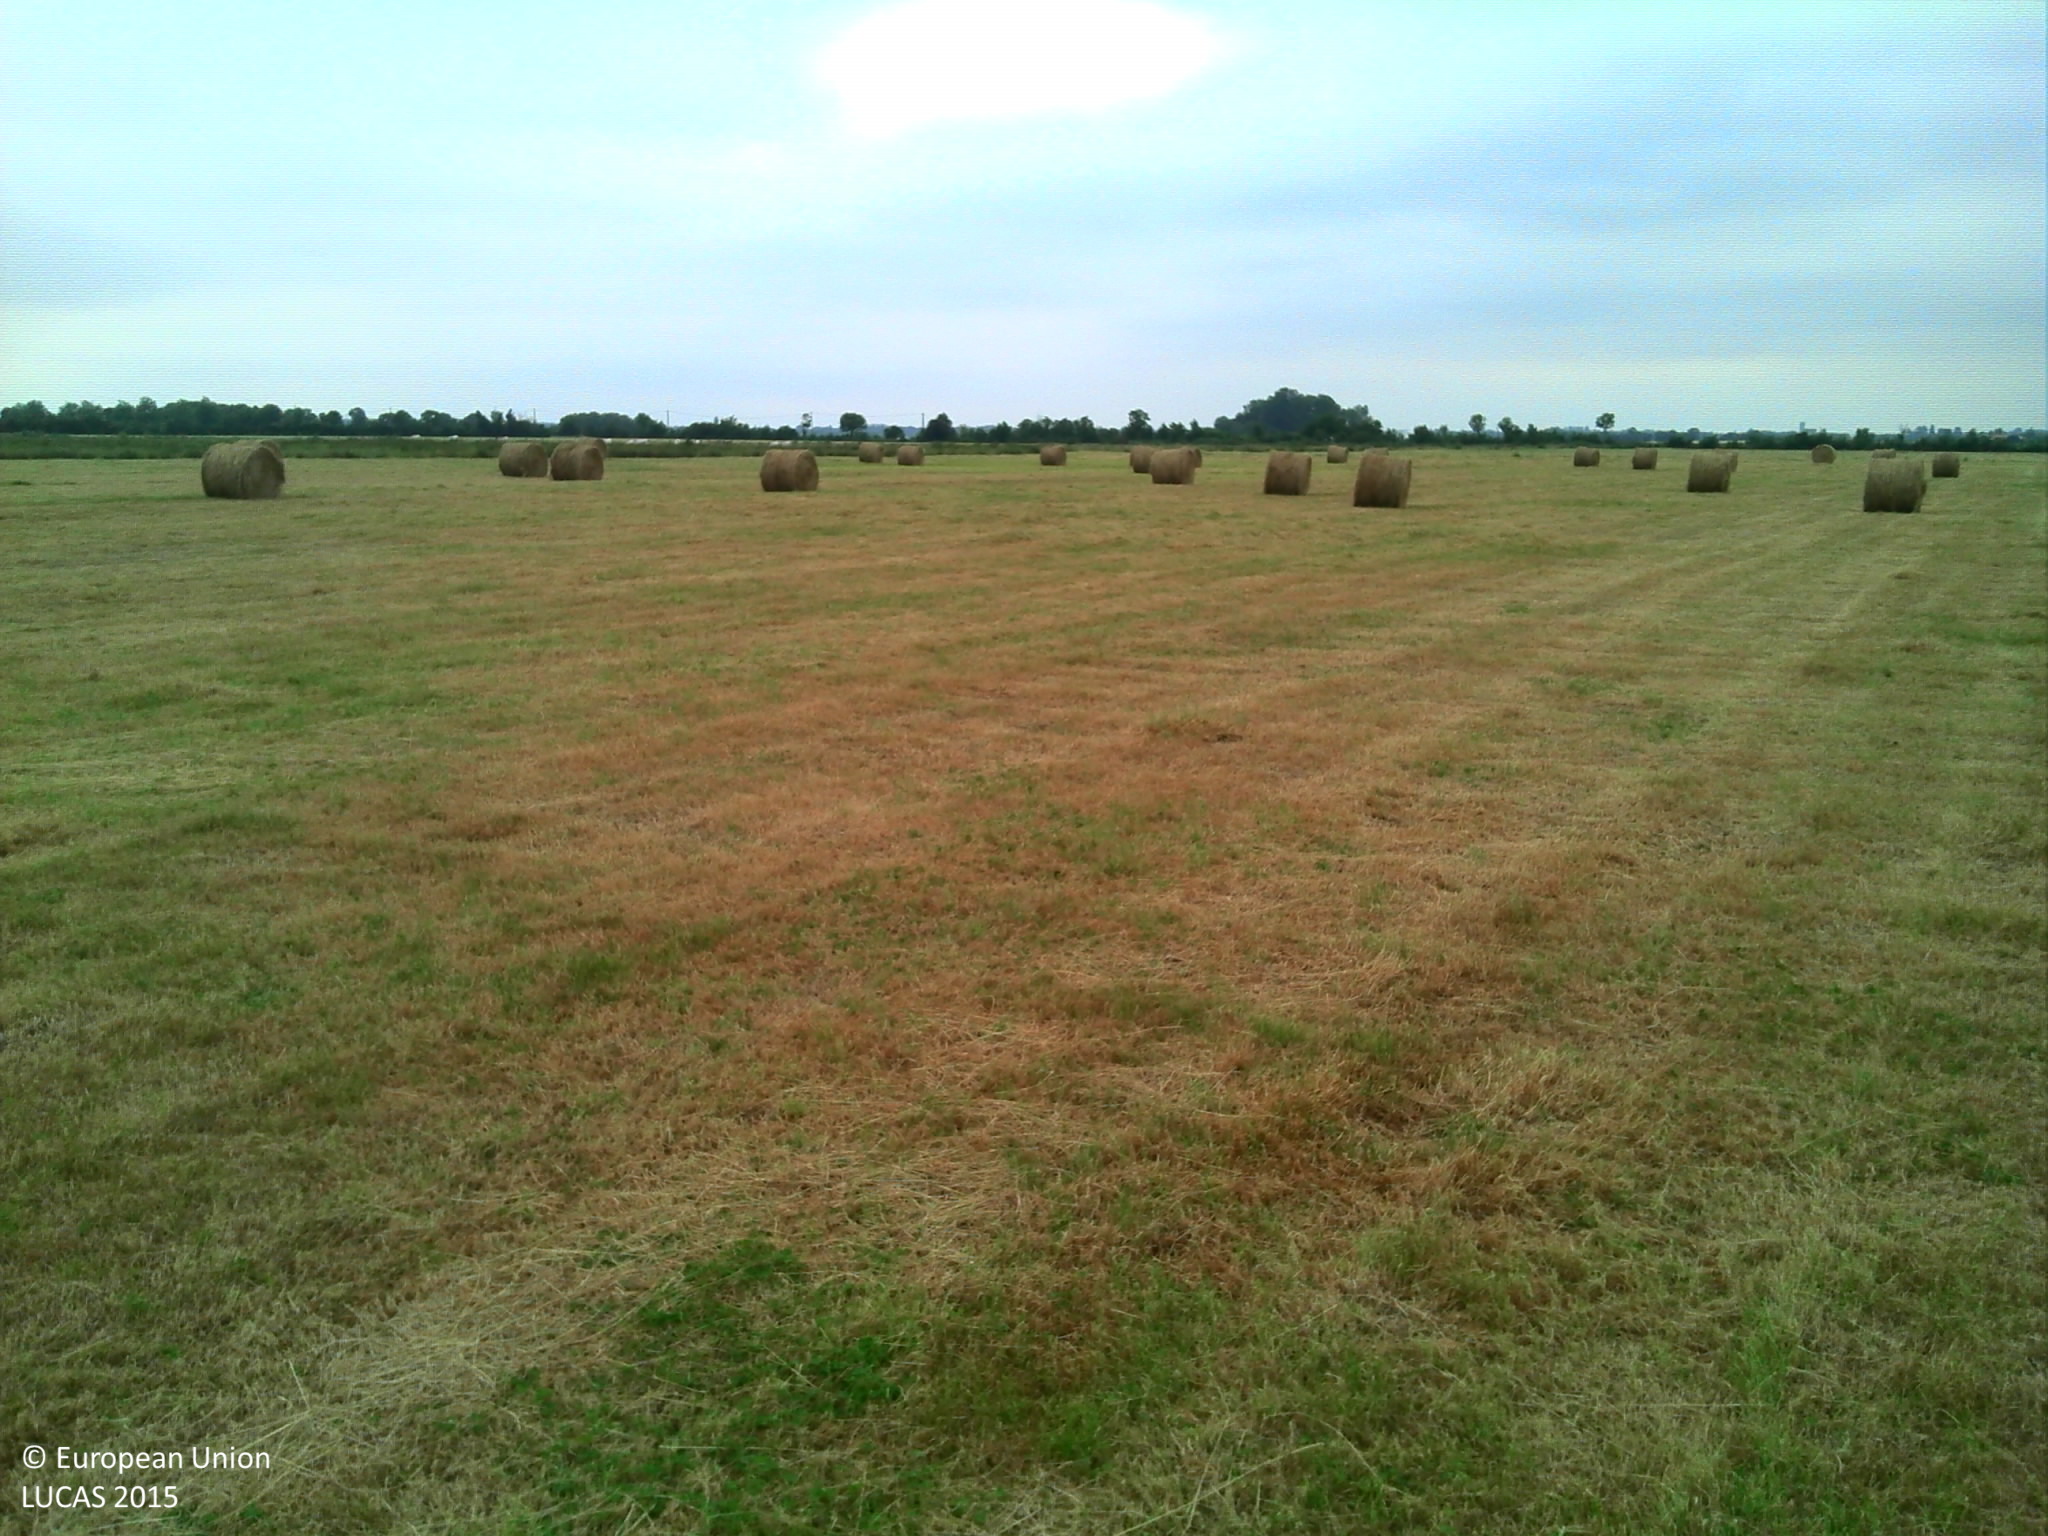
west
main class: Grassland
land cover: Grassland without tree/shrub cover
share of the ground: > 75 %
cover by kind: herbaceous plants 100 %
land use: Agriculture (excluding fallow land and kitchen gardens)
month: June
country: FR
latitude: 45.9733
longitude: -0.9081
